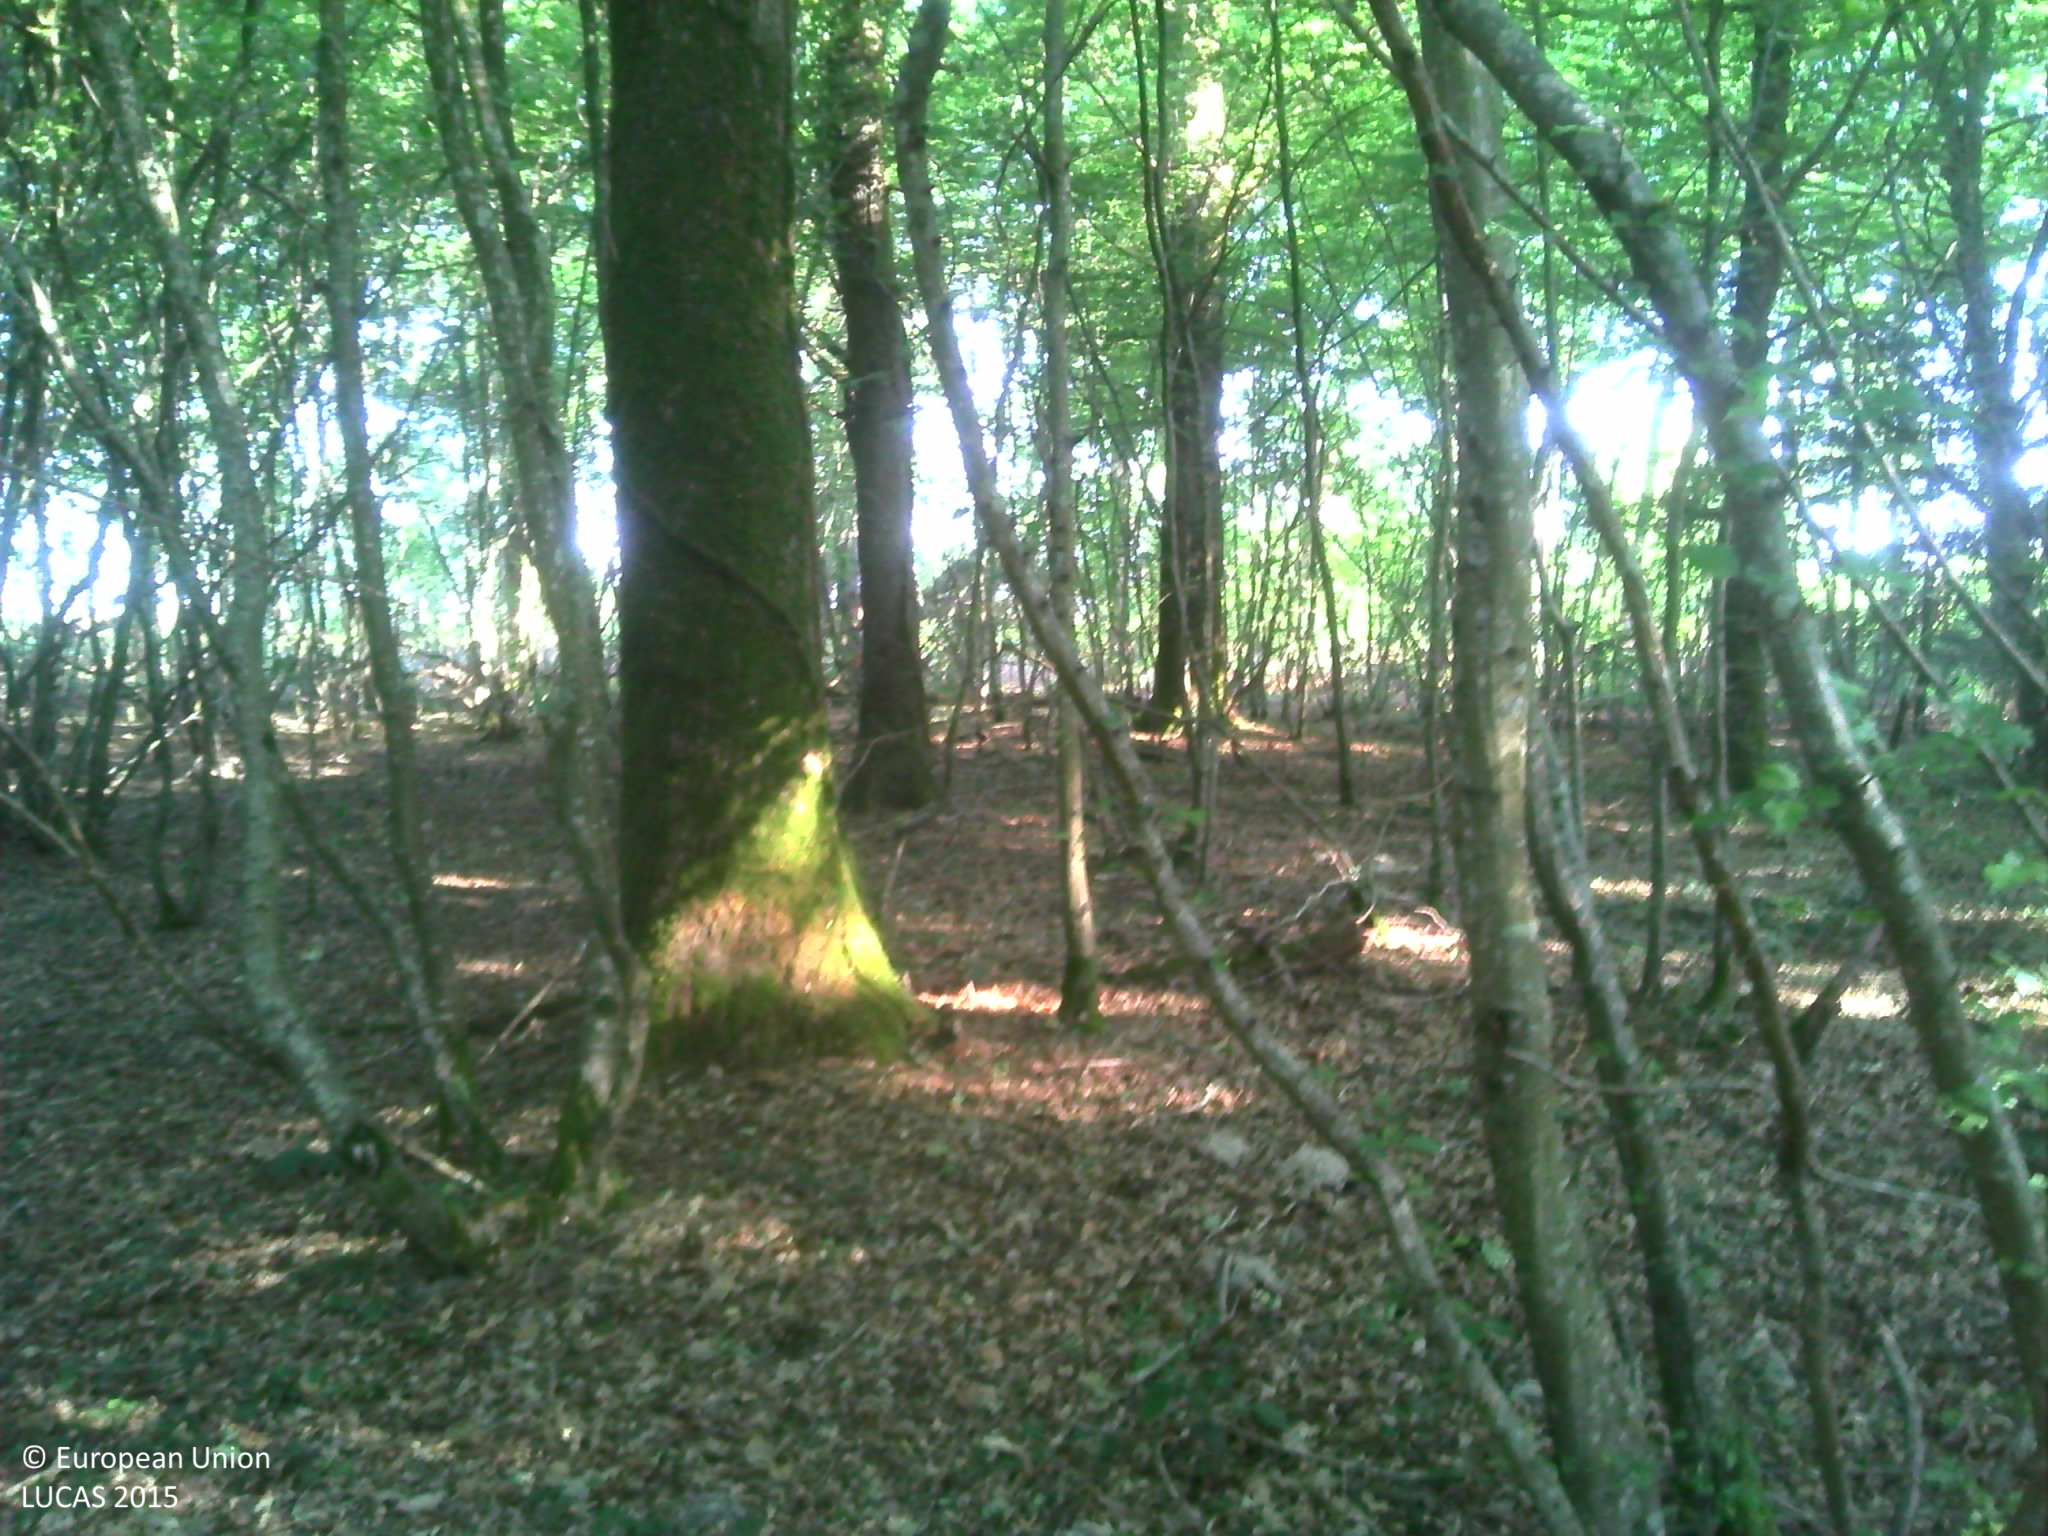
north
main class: Woodland
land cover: Broadleaved woodland
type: mesophytic deciduous forest
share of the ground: > 75 %
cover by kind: broadleaved forest trees 80 %, herbaceous plants 20 %
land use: Forestry
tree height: > 5 m
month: July
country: FR
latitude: 46.7797
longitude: 5.0901
